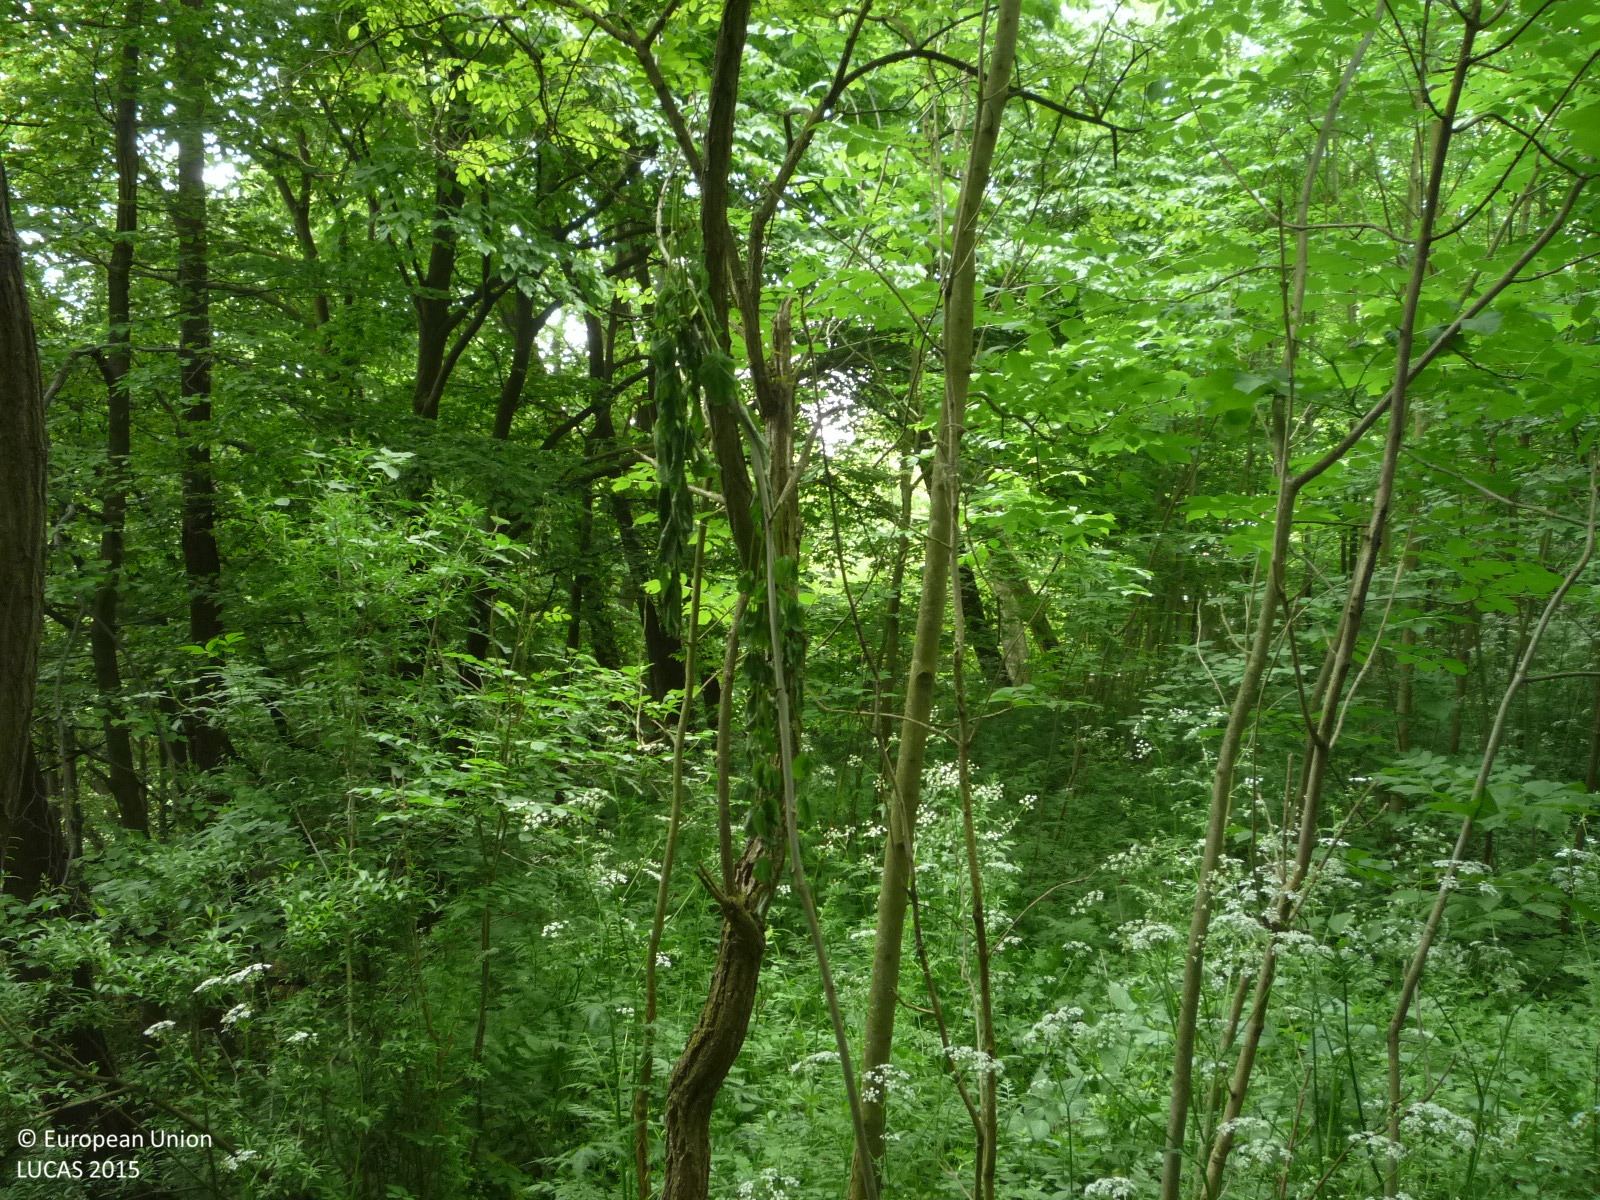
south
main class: Woodland
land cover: Broadleaved woodland
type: mesophytic deciduous forest
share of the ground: > 75 %
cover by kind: broadleaved forest trees 90 %, herbaceous plants 10 %
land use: Semi-natural and natural areas not in use
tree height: > 5 m
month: May
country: CZ
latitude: 50.4357
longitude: 14.5494
